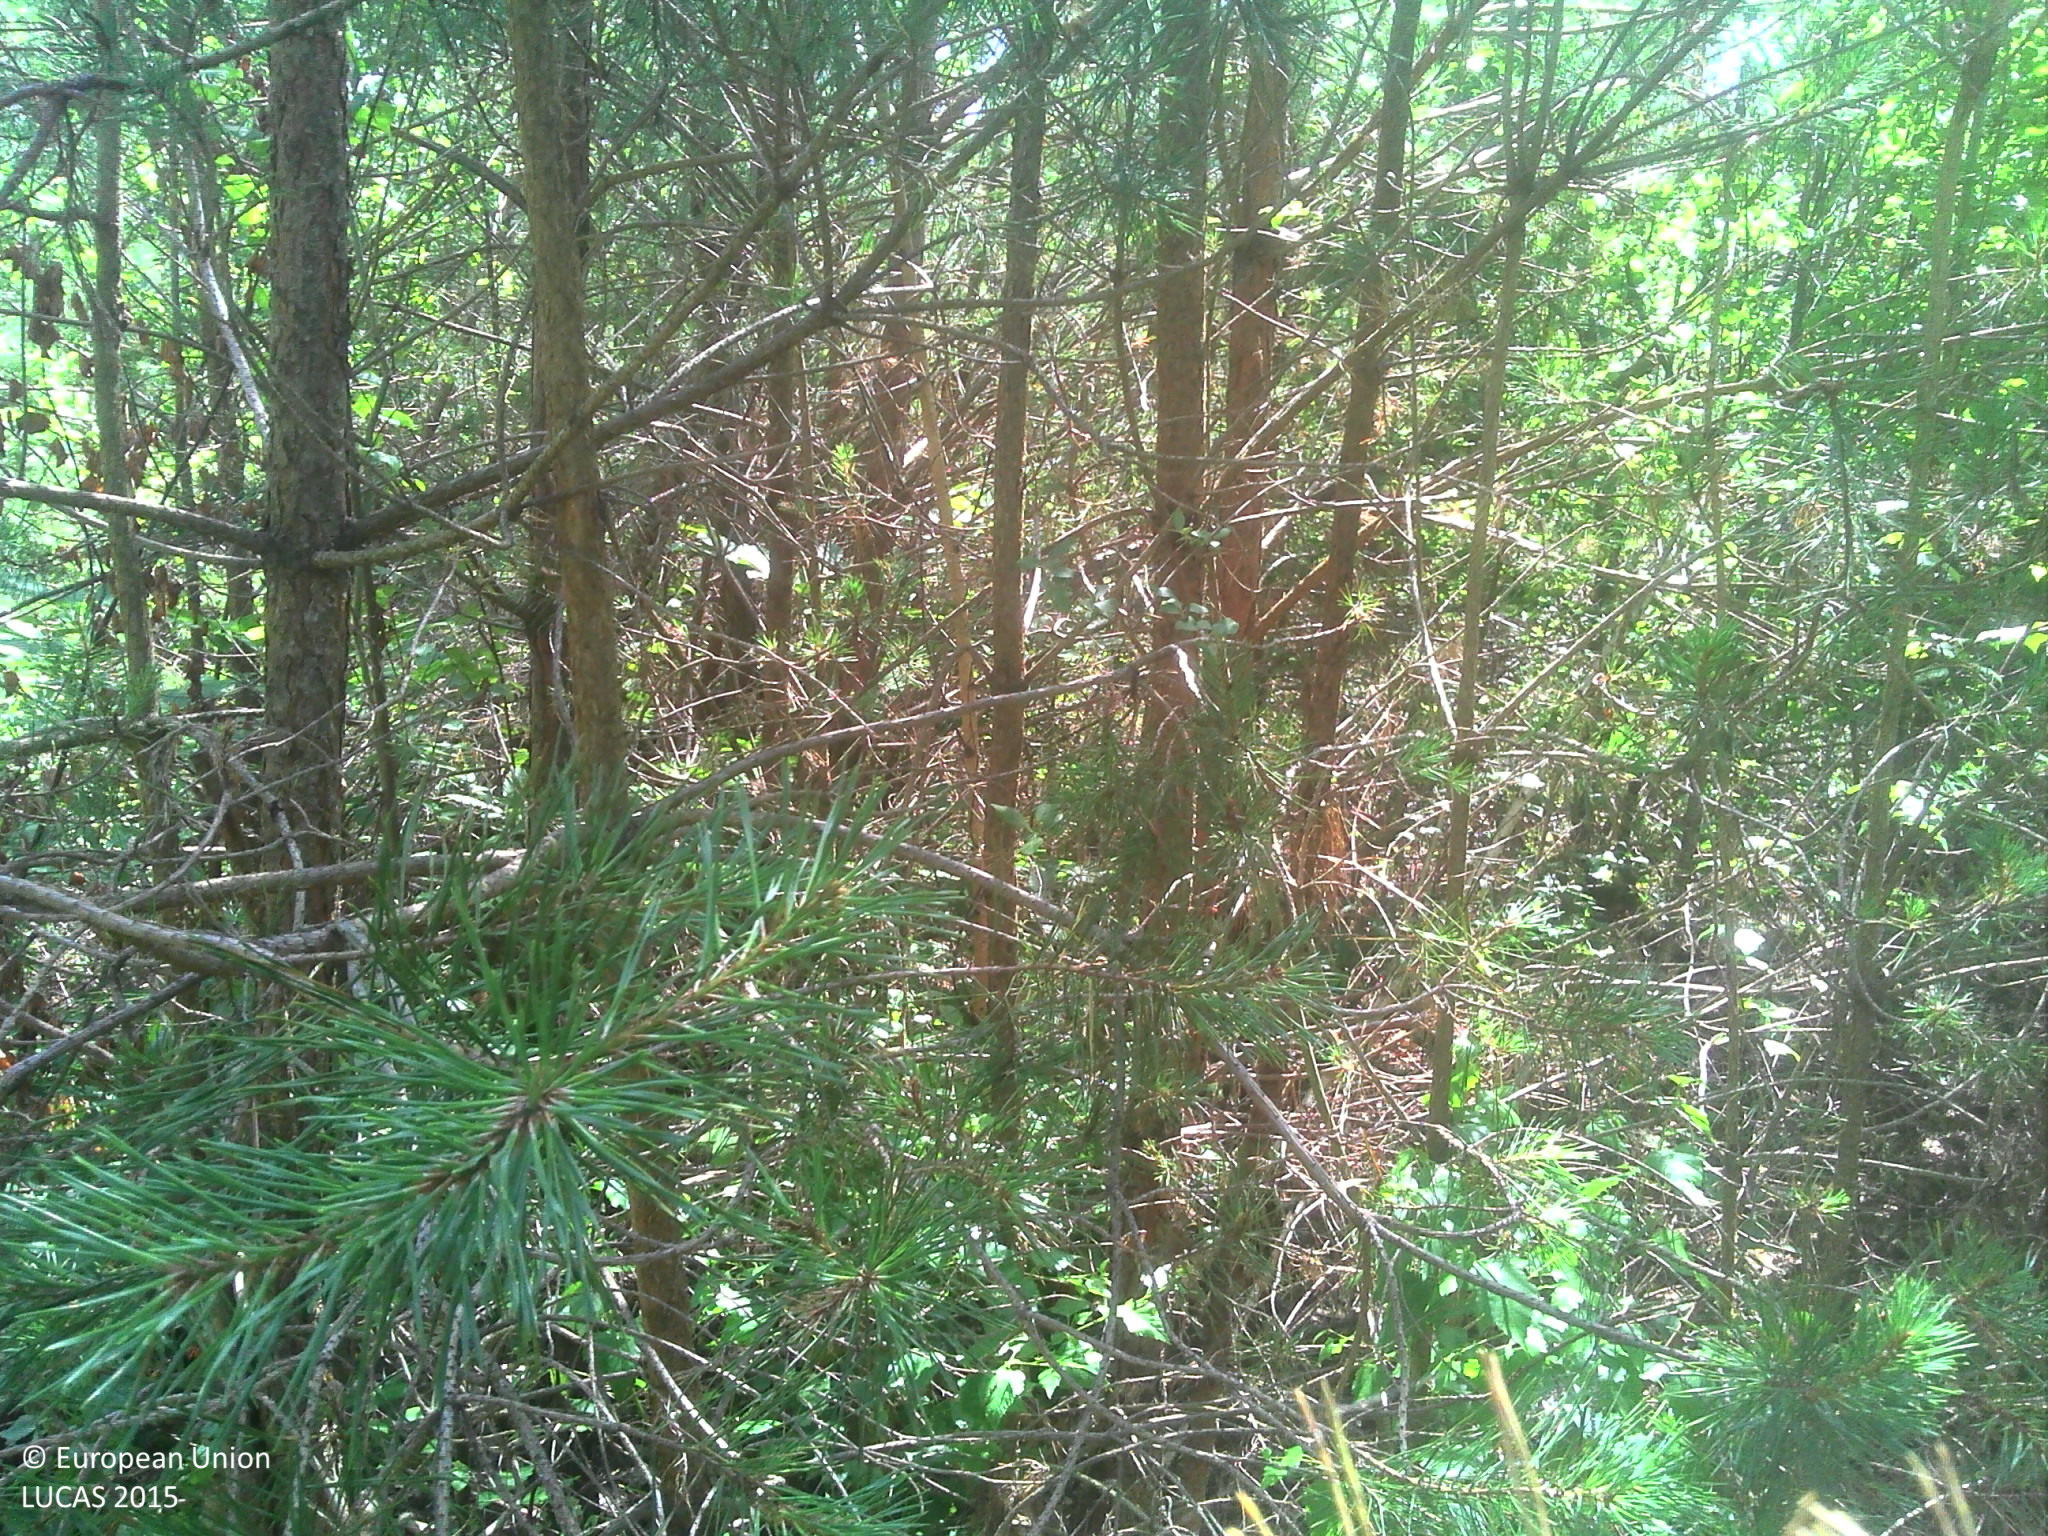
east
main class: Woodland
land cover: Pine dominated mixed woodland
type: thermophilous deciduous forest
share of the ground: > 75 %
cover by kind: unconsolidated bare surface 50 %, coniferous forest trees 30 %, broadleaved forest trees 10 %, herbaceous plants 10 %
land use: Forestry
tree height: > 5 m
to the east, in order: Pine dominated mixed woodland; Ditches and canals; Pine dominated mixed woodland
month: June
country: FR
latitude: 47.3383
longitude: 1.5565
